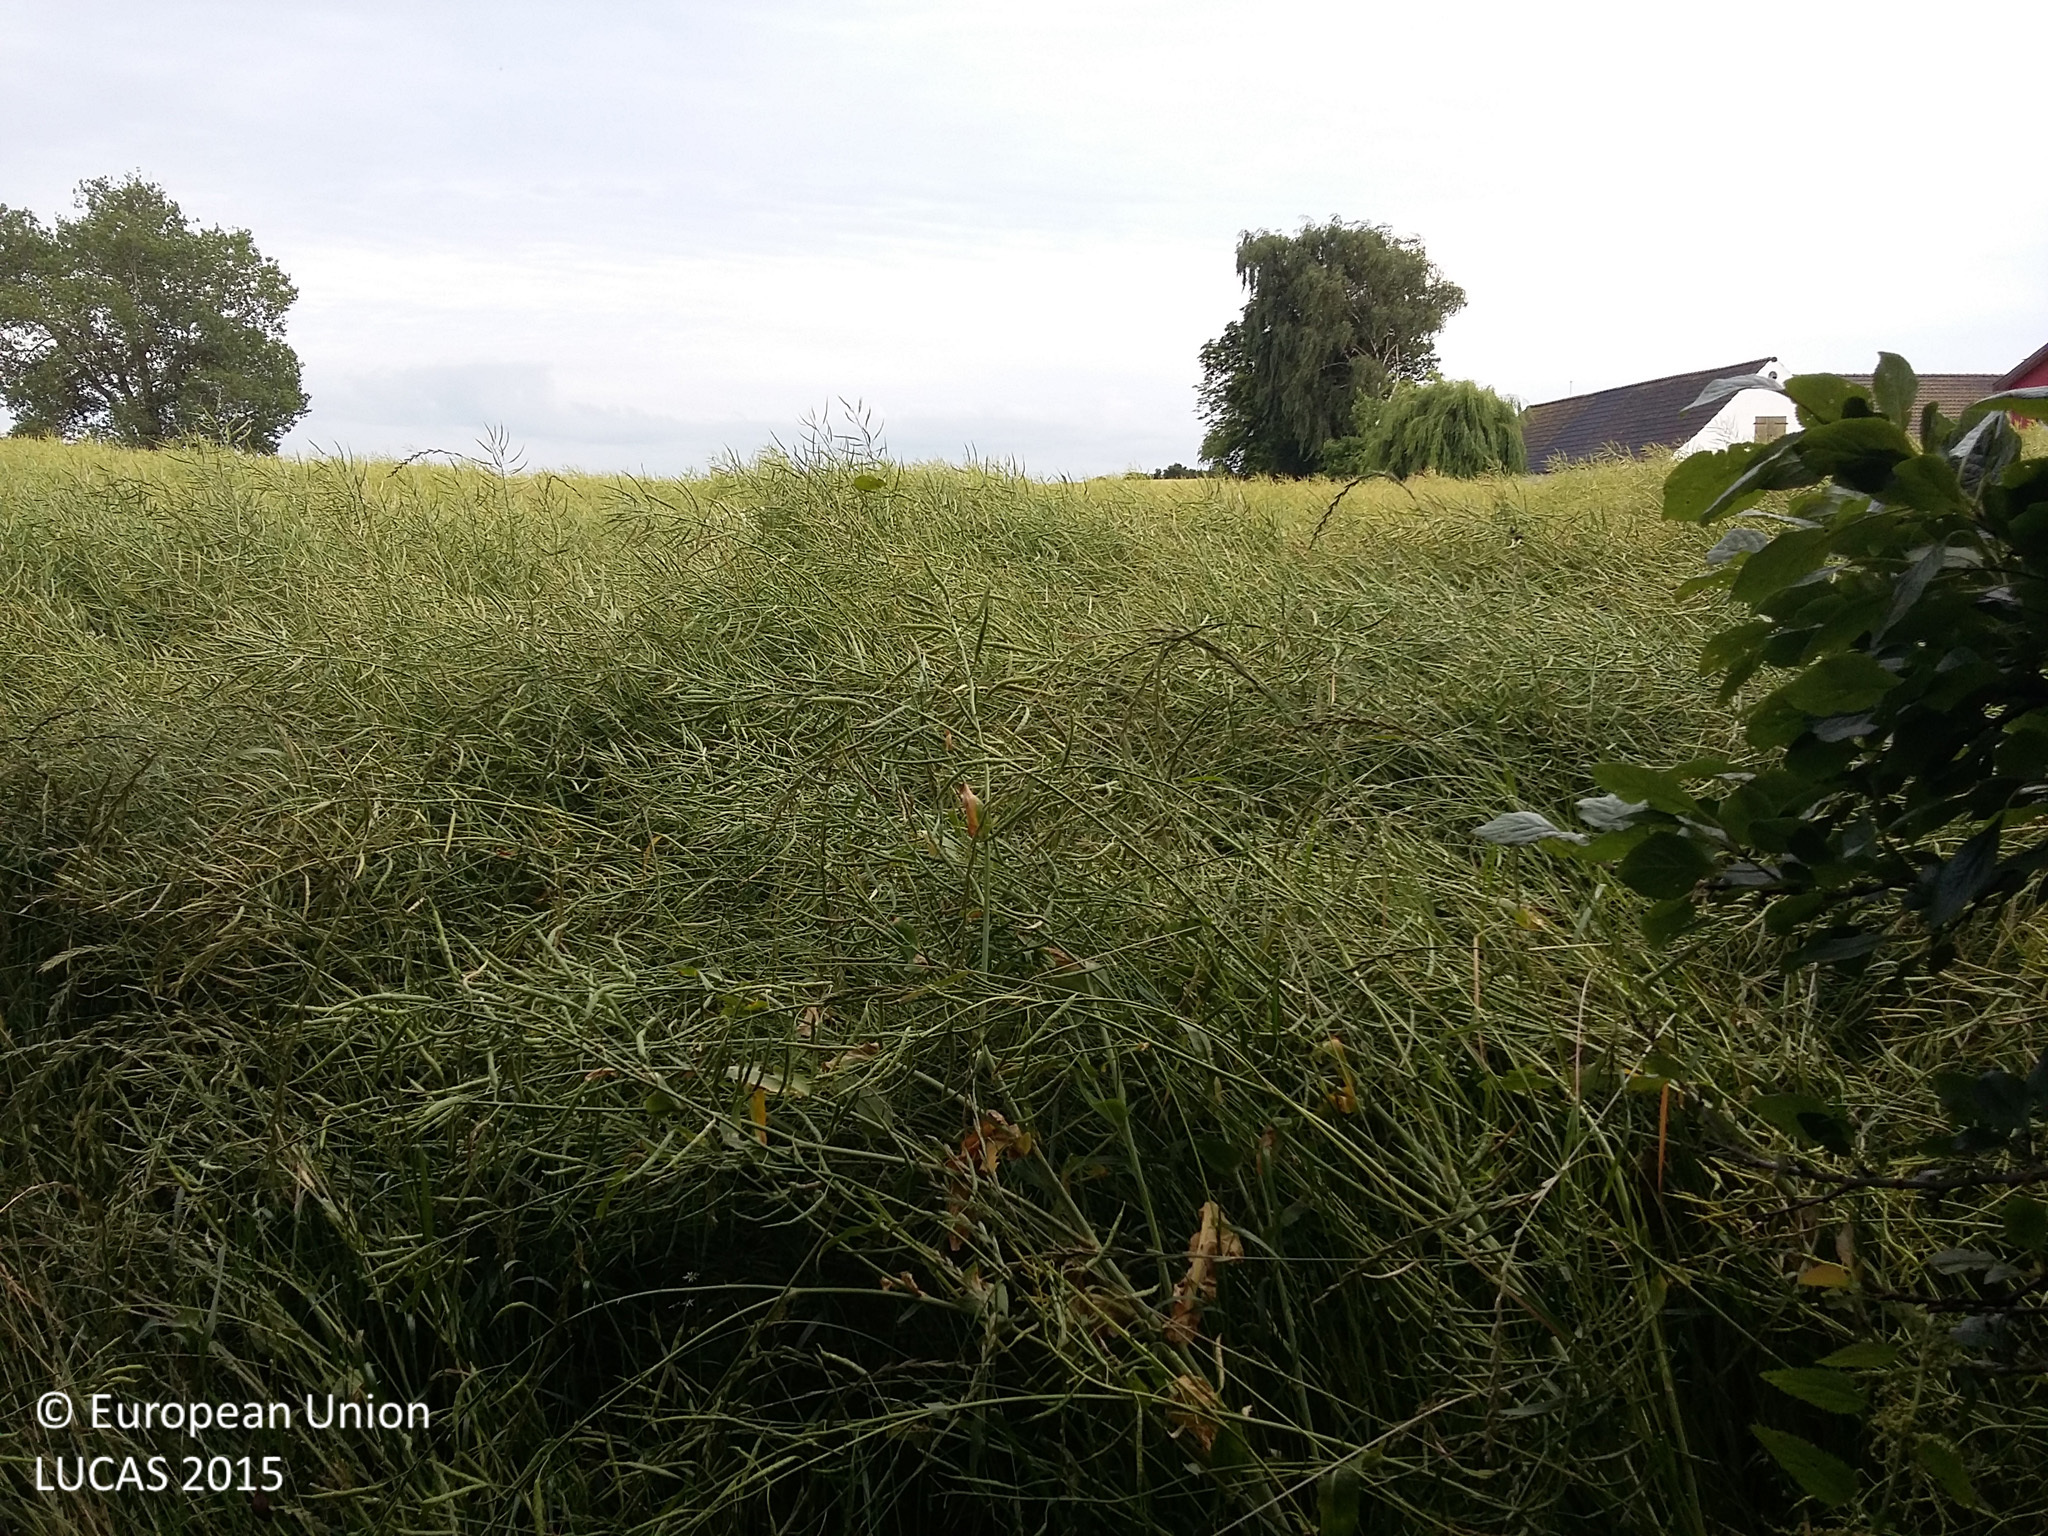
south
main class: Woodland
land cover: Broadleaved woodland
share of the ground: > 75 %
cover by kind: broadleaved forest trees 90 %, herbaceous plants 10 %
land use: Forestry
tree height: > 5 m
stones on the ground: < 10 %
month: July
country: DK
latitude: 55.5691
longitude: 11.3784
